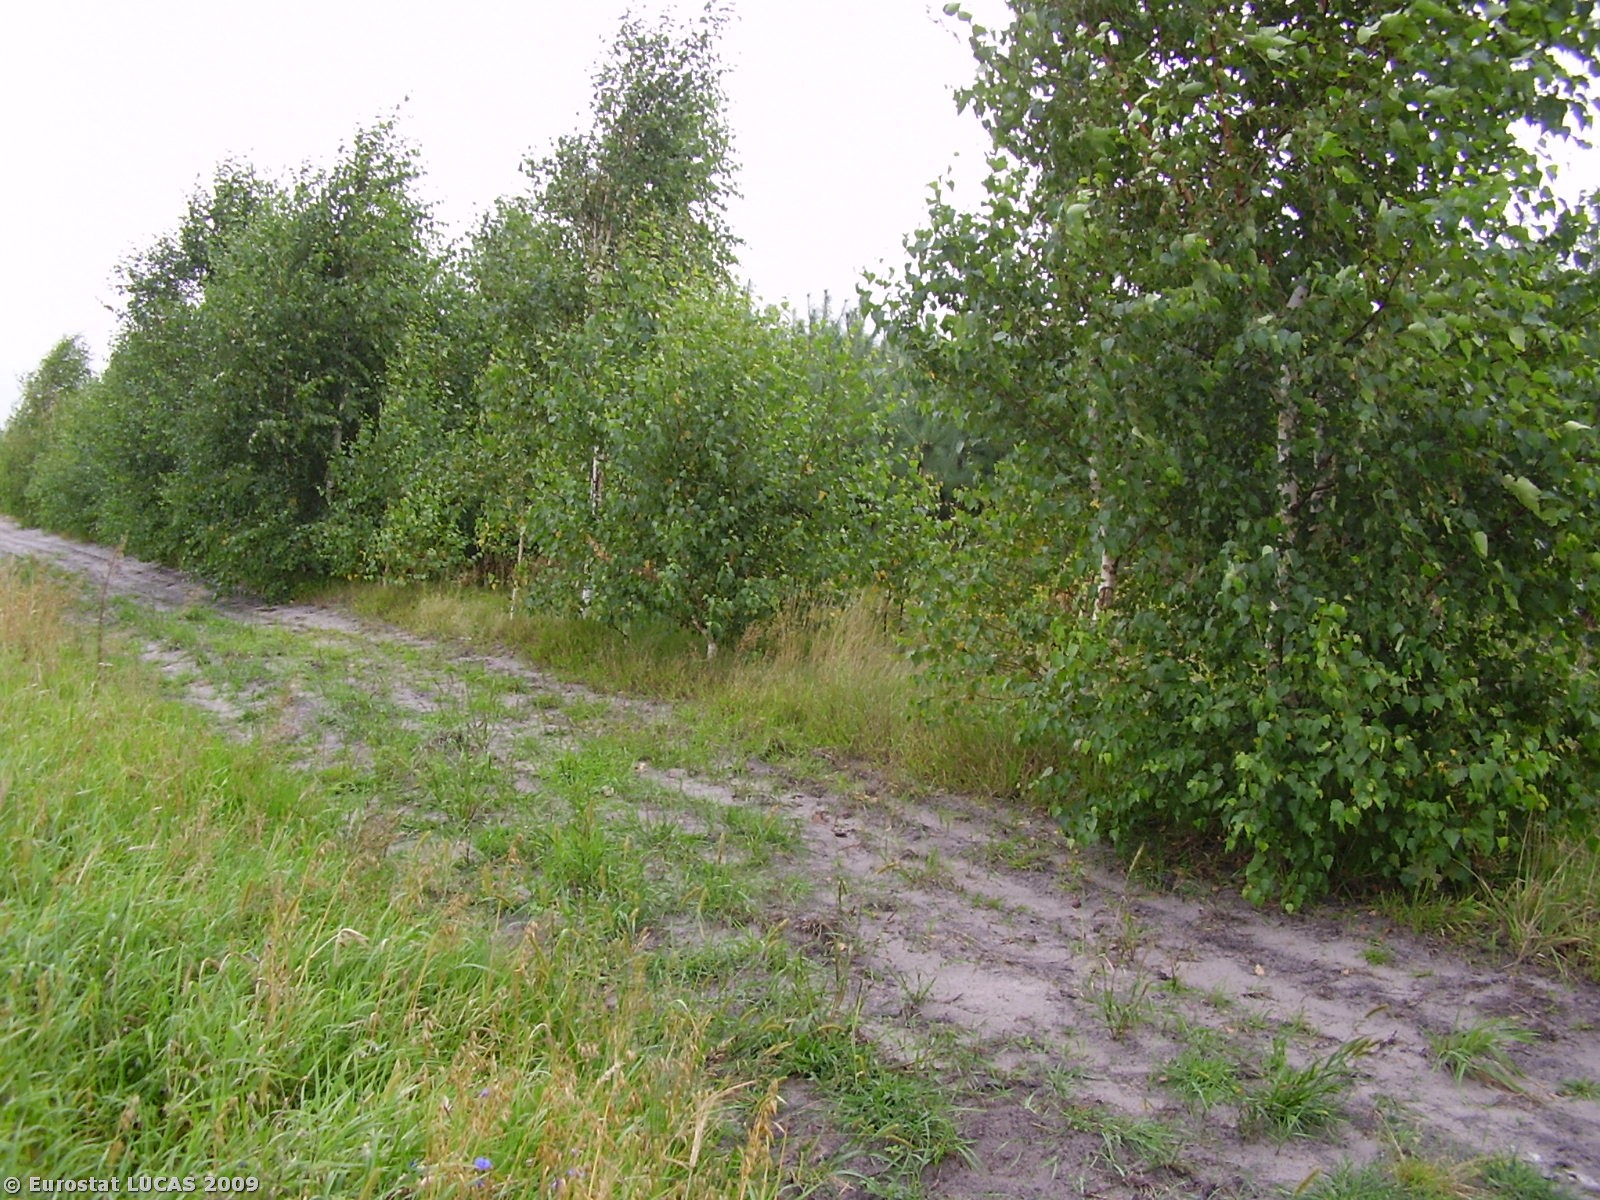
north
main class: Grassland
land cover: Spontaneously vegetated surfaces
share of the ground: > 75 %
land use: Fallow land
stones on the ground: < 10 %
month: April
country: PL
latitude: 51.5314
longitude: 16.8278
